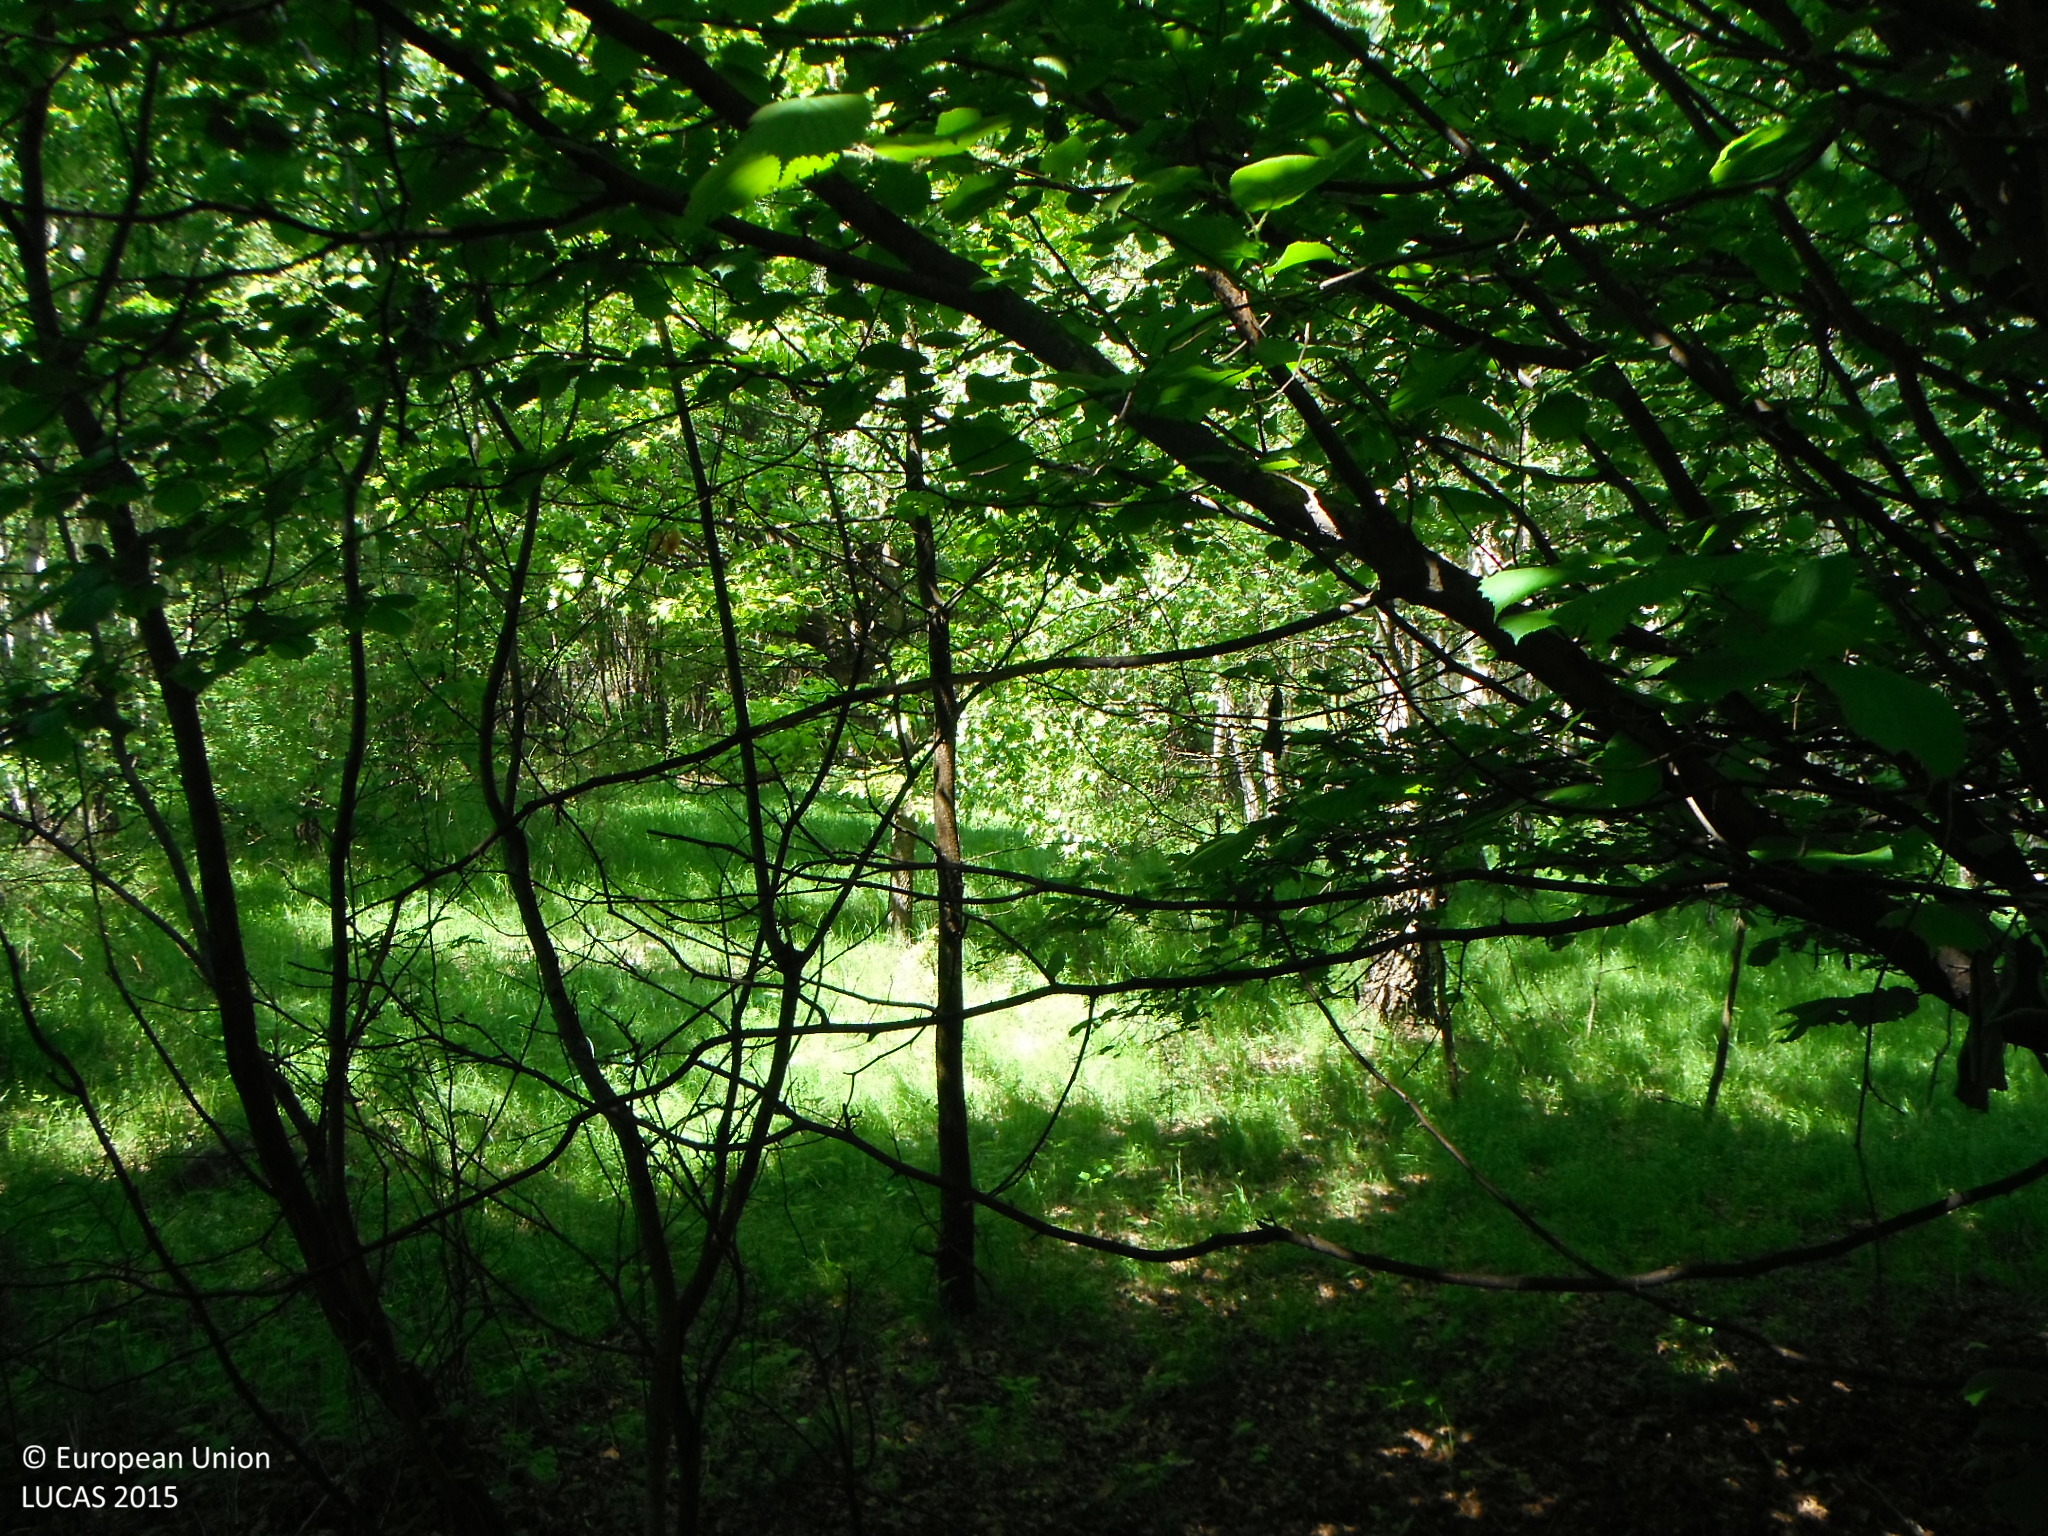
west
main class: Woodland
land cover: Broadleaved woodland
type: acidophilous oak and oak-birch forest
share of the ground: > 75 %
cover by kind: broadleaved forest trees 100 %
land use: Forestry
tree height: > 5 m
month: May
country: SK
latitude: 48.4334
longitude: 19.0086
